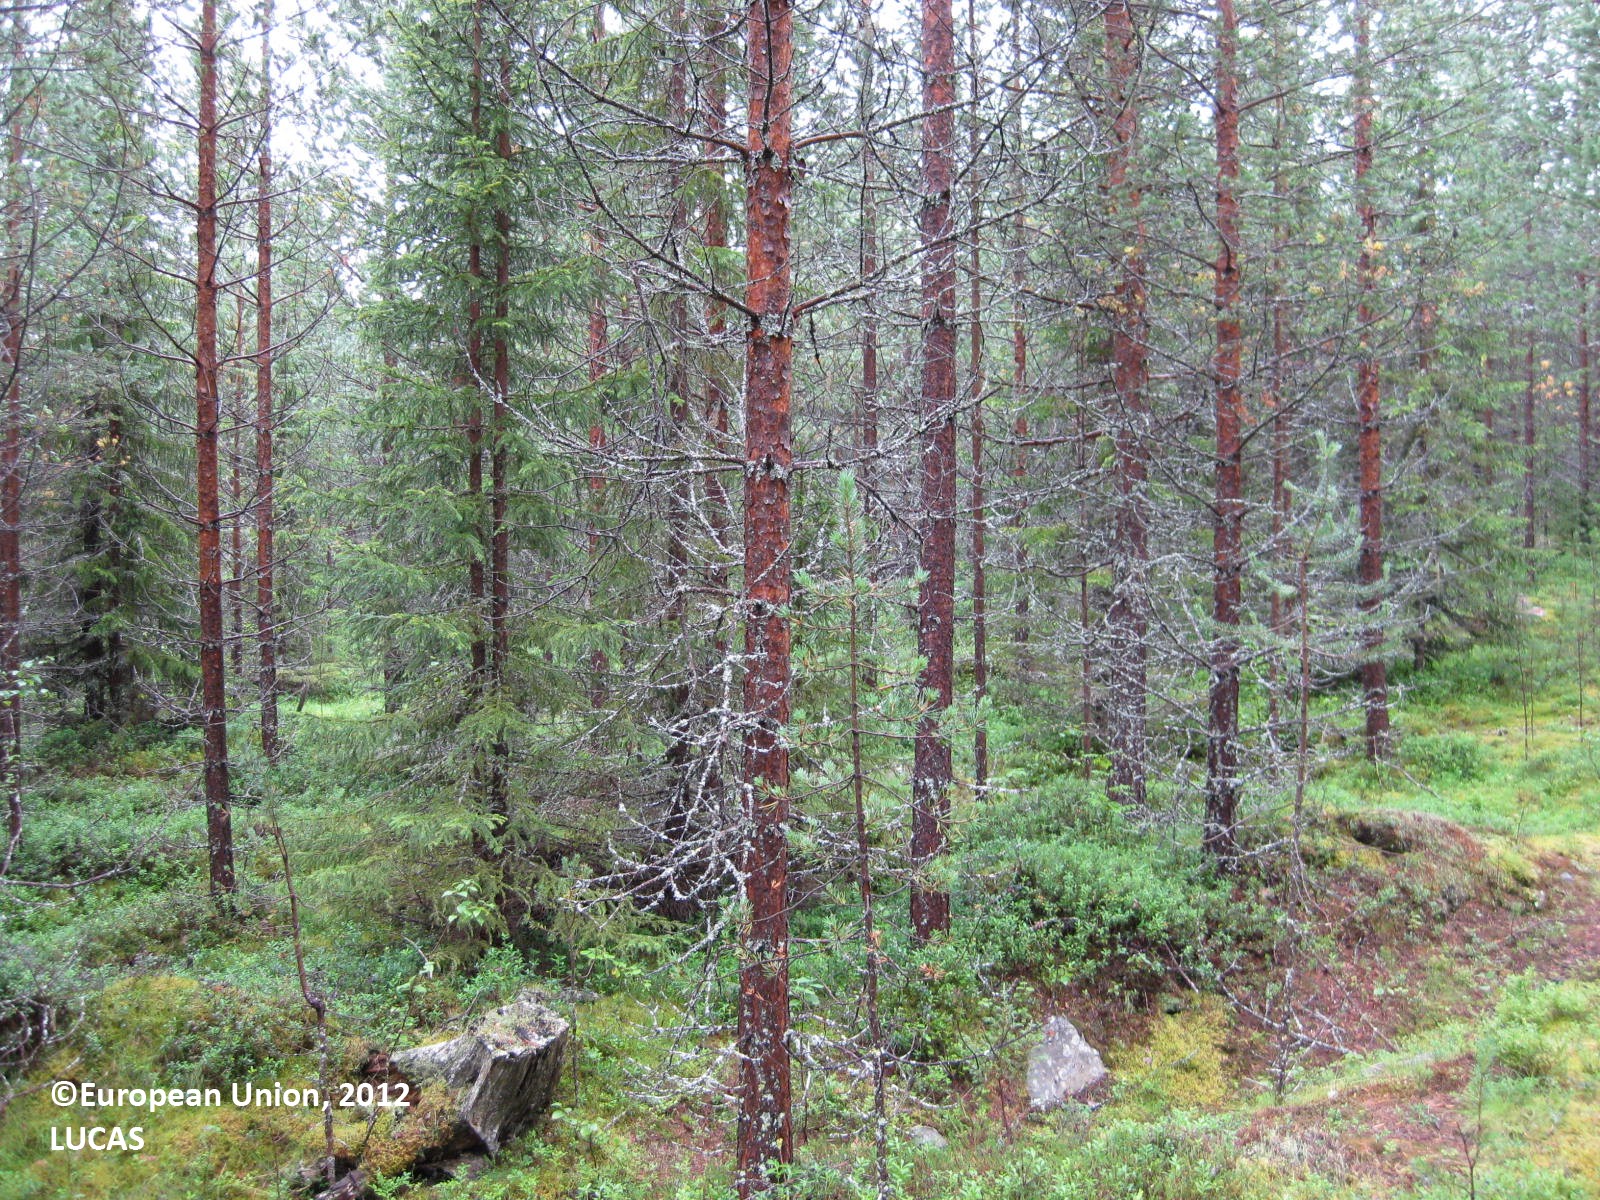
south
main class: Woodland
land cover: Other coniferous woodland
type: boreal forest
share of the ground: 50 - 75 %
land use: Forestry
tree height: > 5 m
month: August
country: FI
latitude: 65.8291
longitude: 28.0676
